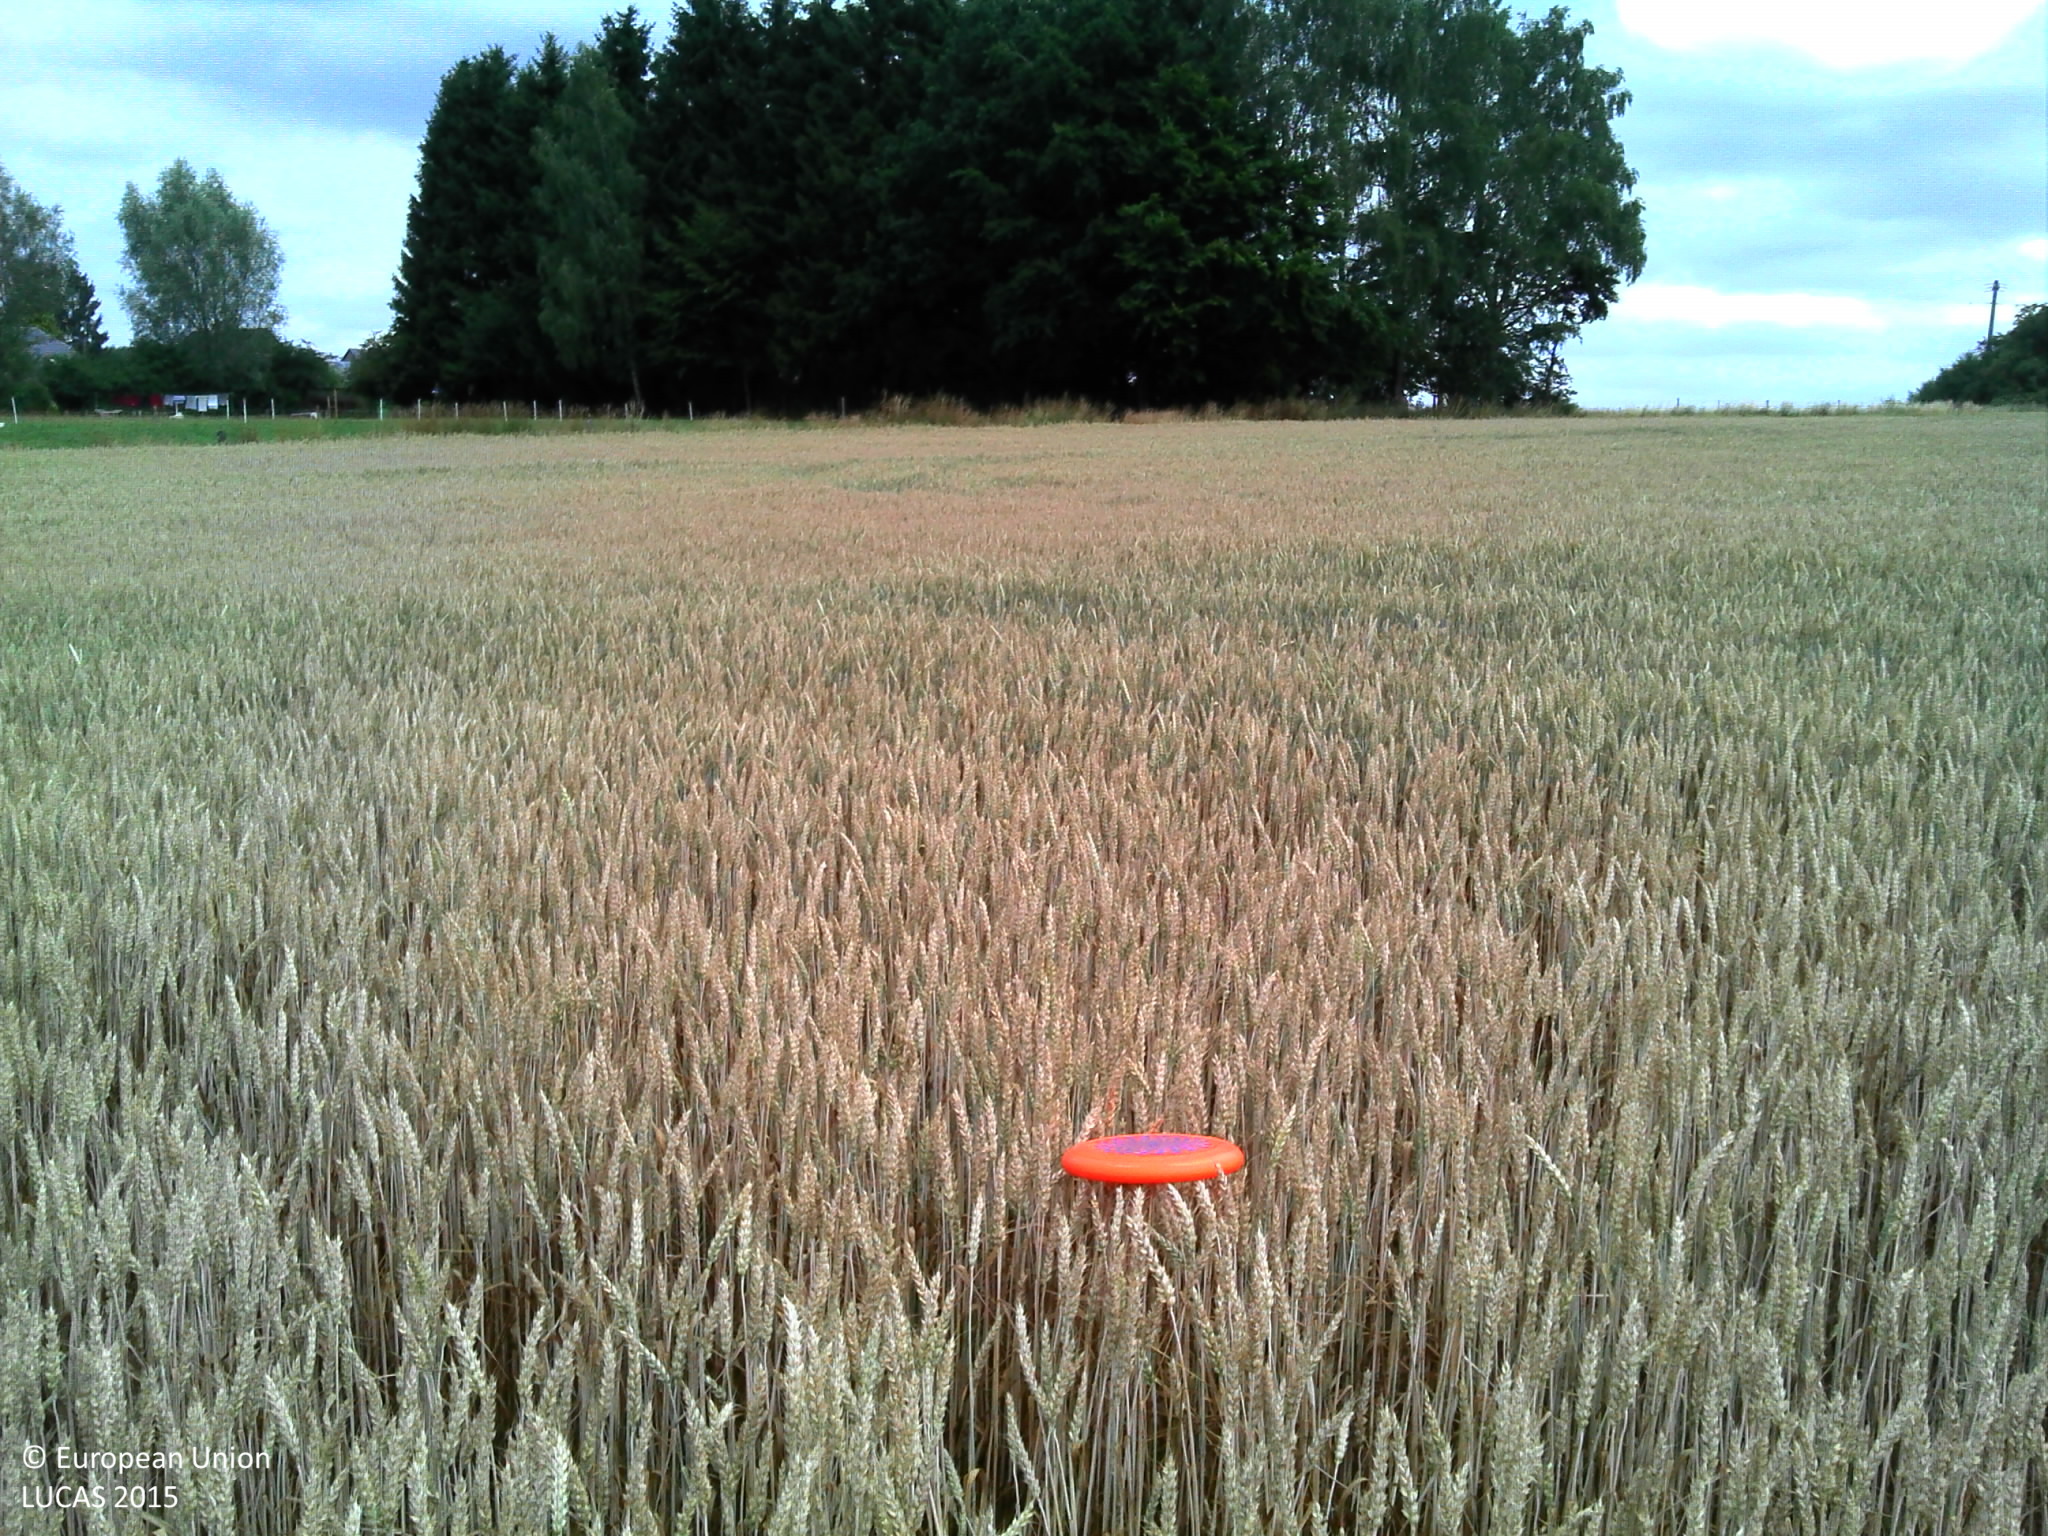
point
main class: Cropland
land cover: Common wheat
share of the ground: > 75 %
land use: Agriculture (excluding fallow land and kitchen gardens)
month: July
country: BE
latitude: 49.7223
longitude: 5.6293
